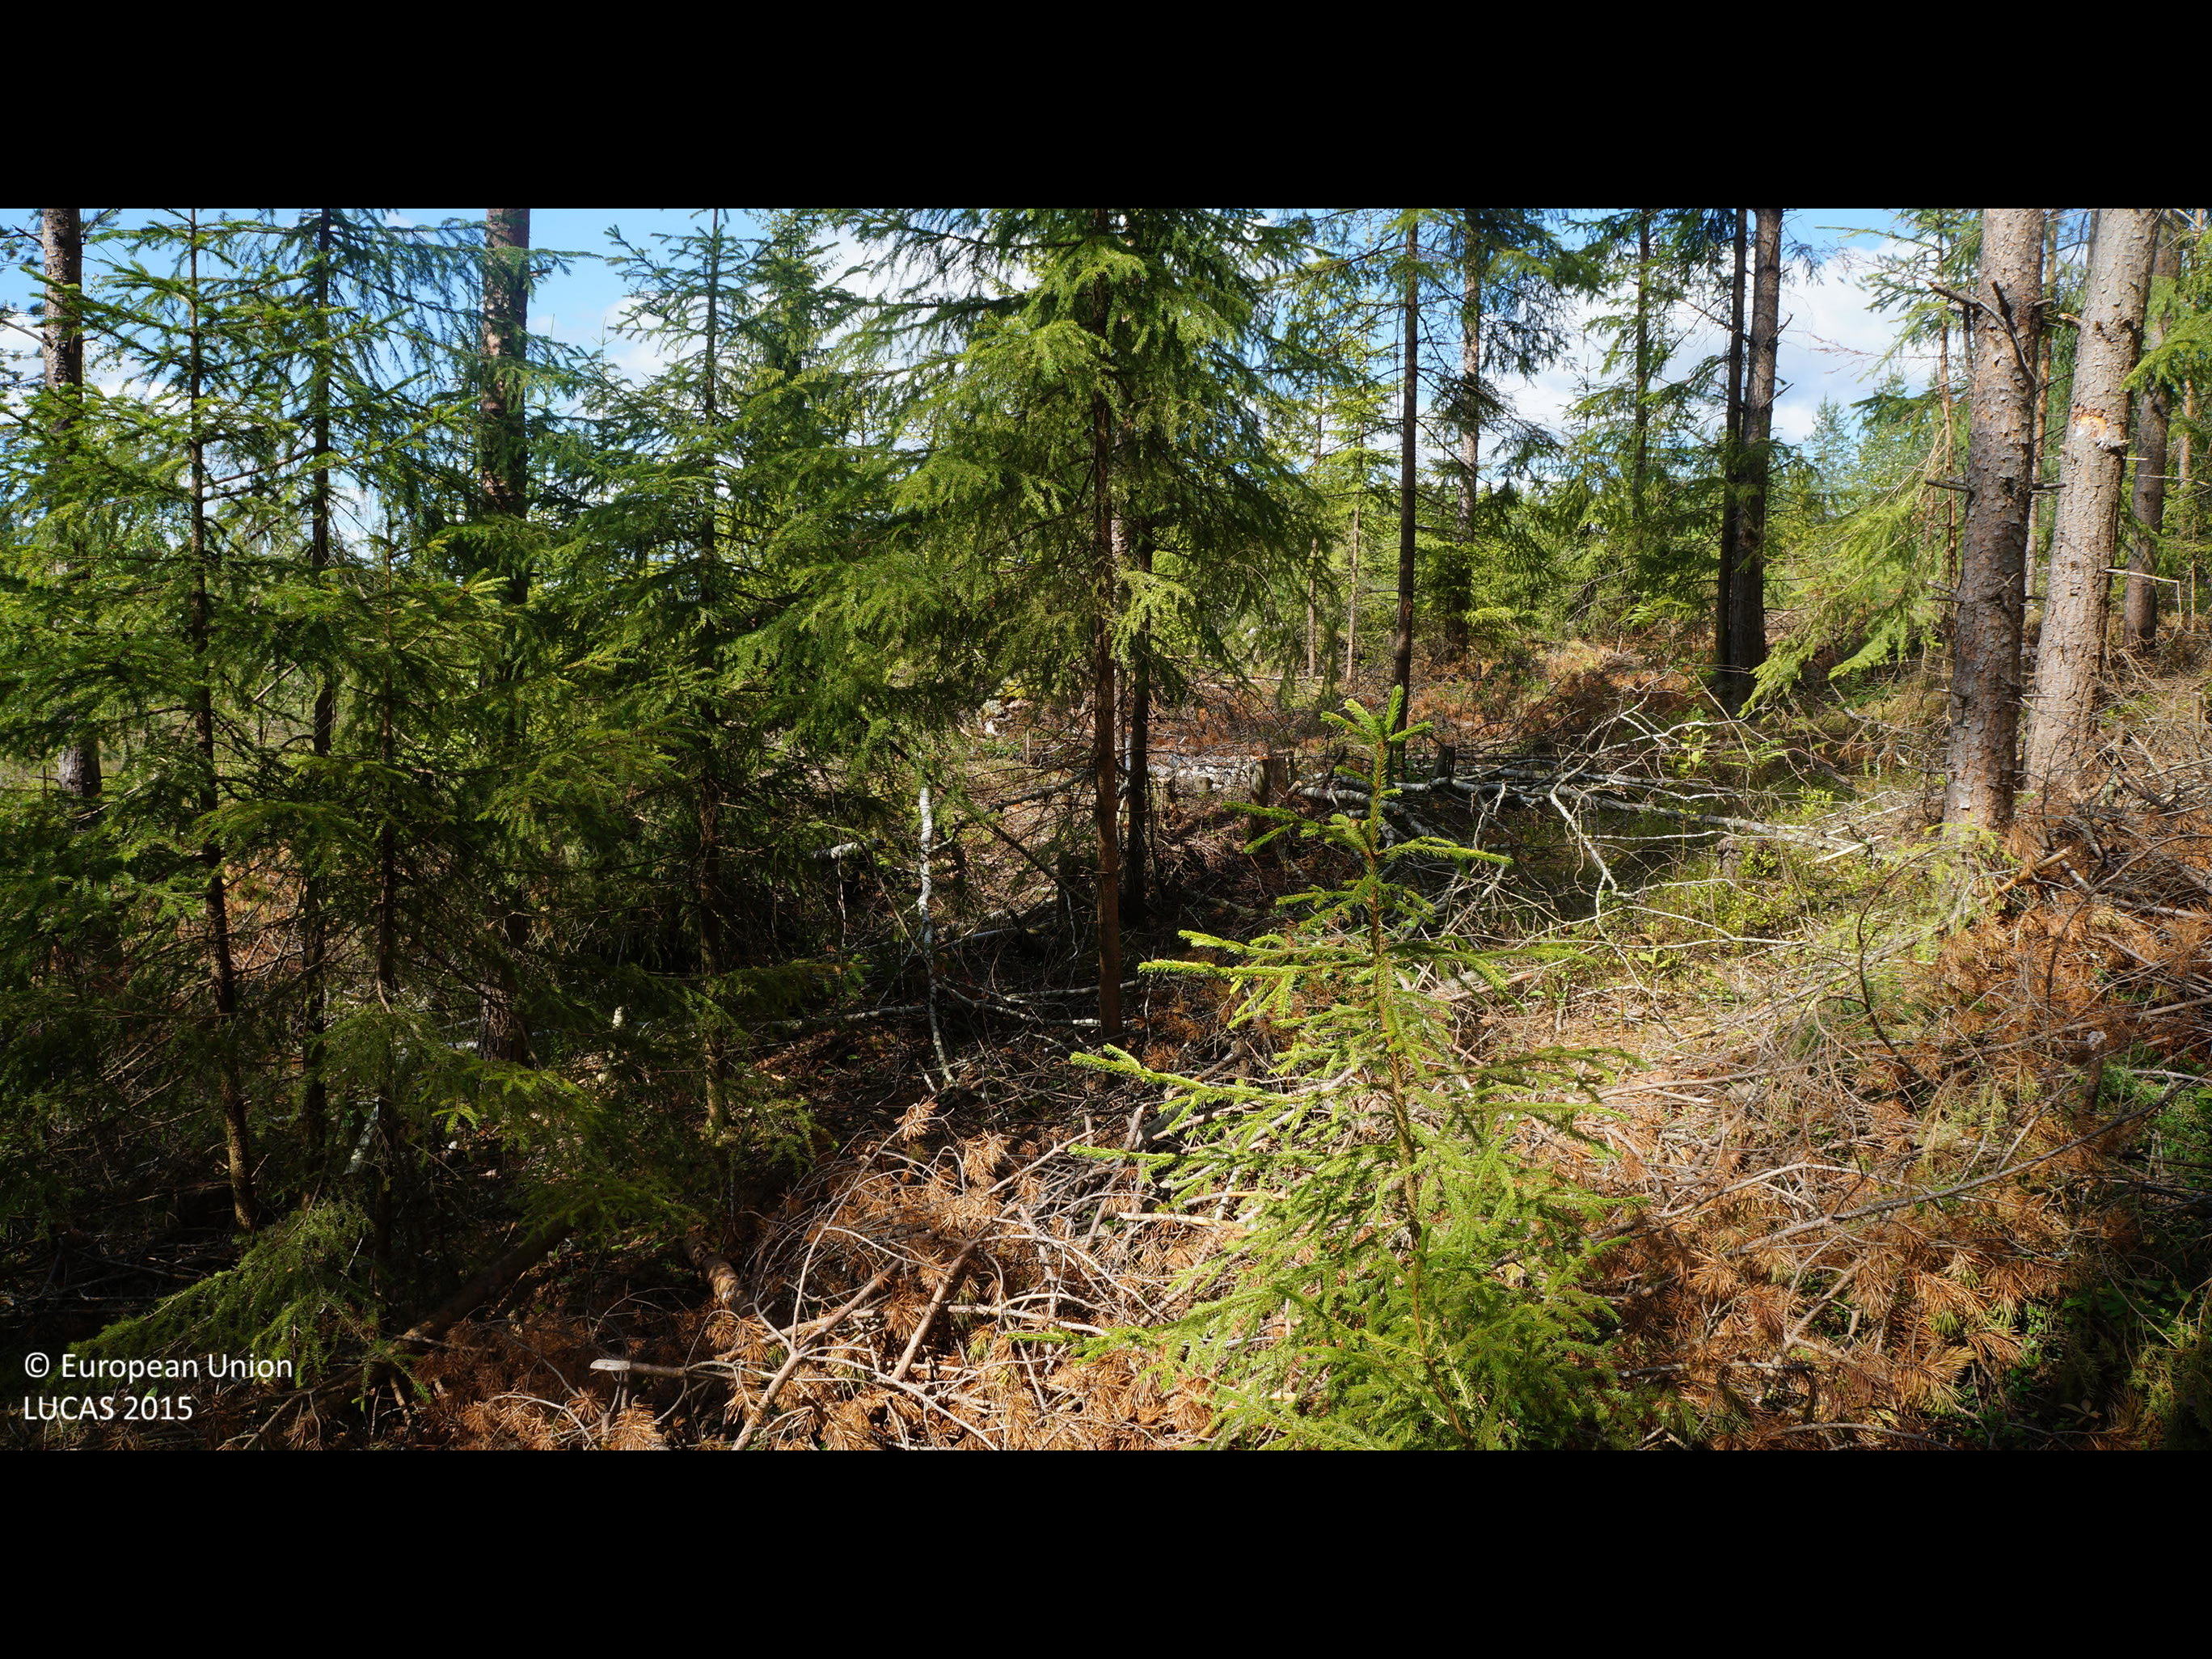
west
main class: Woodland
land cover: Other coniferous woodland
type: boreal forest
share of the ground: 50 - 75 %
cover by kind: coniferous forest trees 55 %, shrubs 30 %, lichens and mosses 10 %
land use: Forestry
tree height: > 5 m
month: July
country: FI
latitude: 63.9241
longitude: 24.3667
